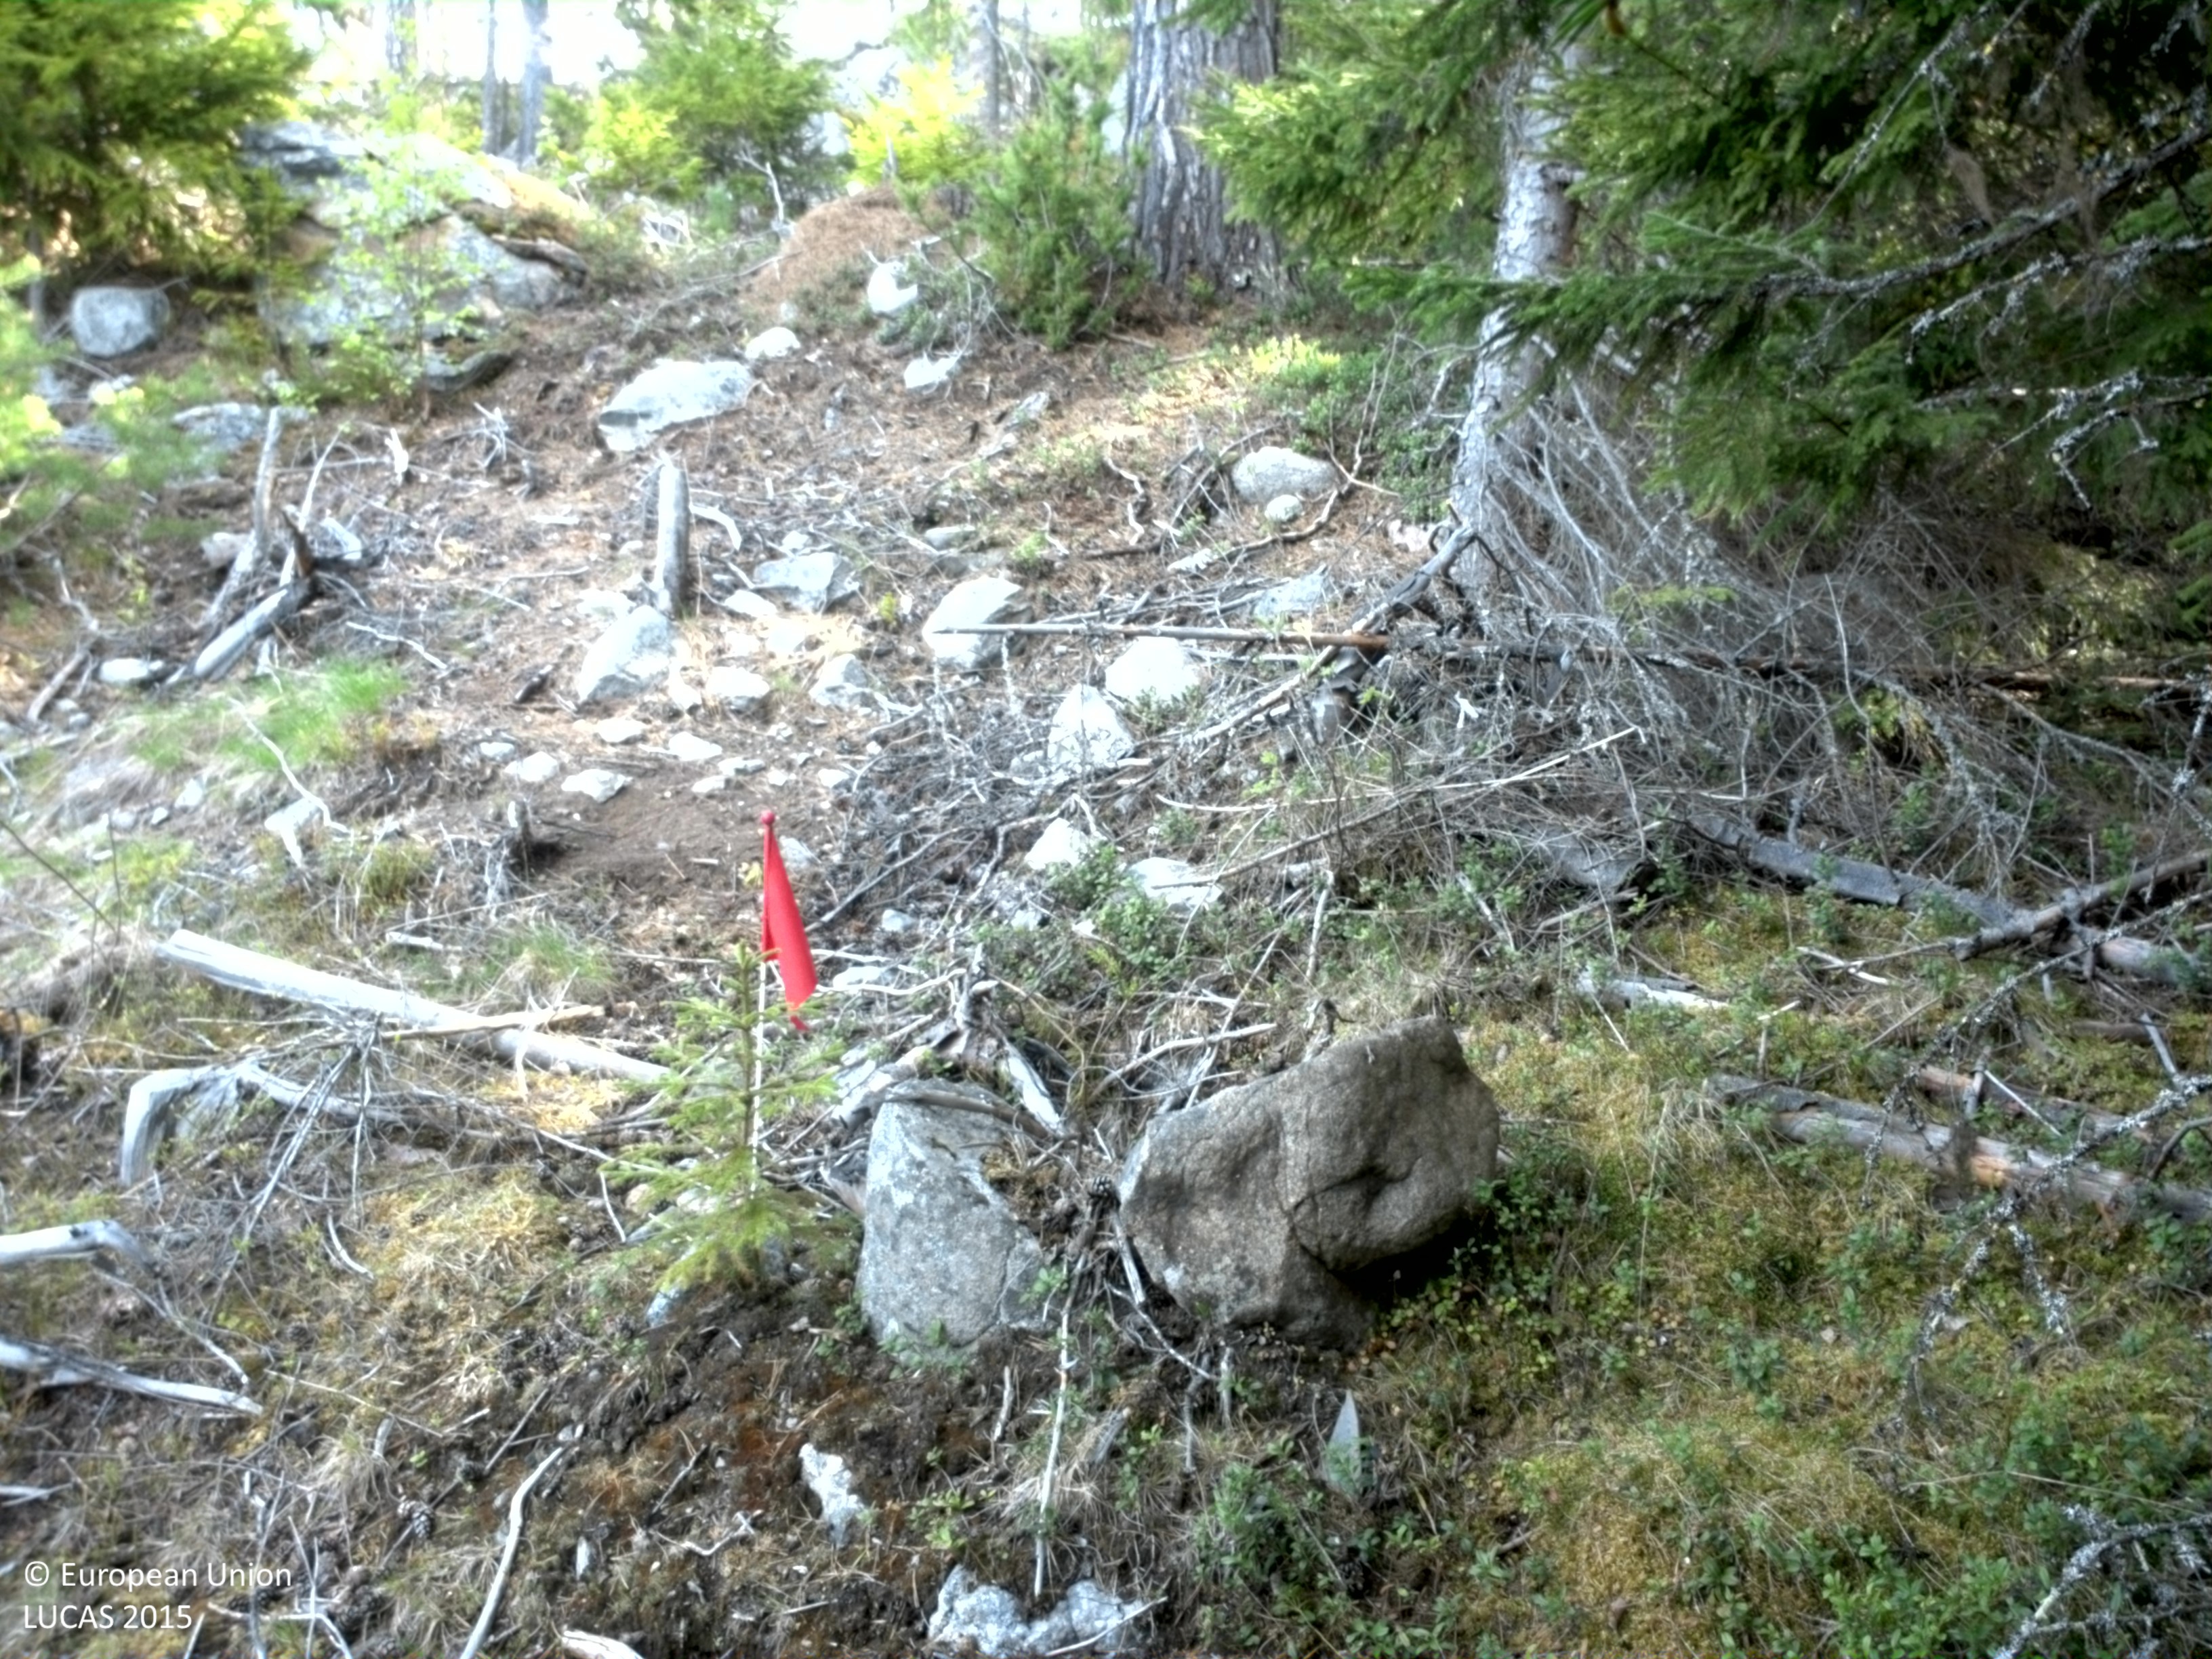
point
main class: Woodland
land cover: Spruce dominated coniferous woodland
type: boreal forest
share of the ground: > 75 %
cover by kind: coniferous forest trees 75 %, shrubs 15 %, lichens and mosses 10 %
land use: Forestry
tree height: > 5 m
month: May
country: SE
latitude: 62.9937
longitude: 17.7352
